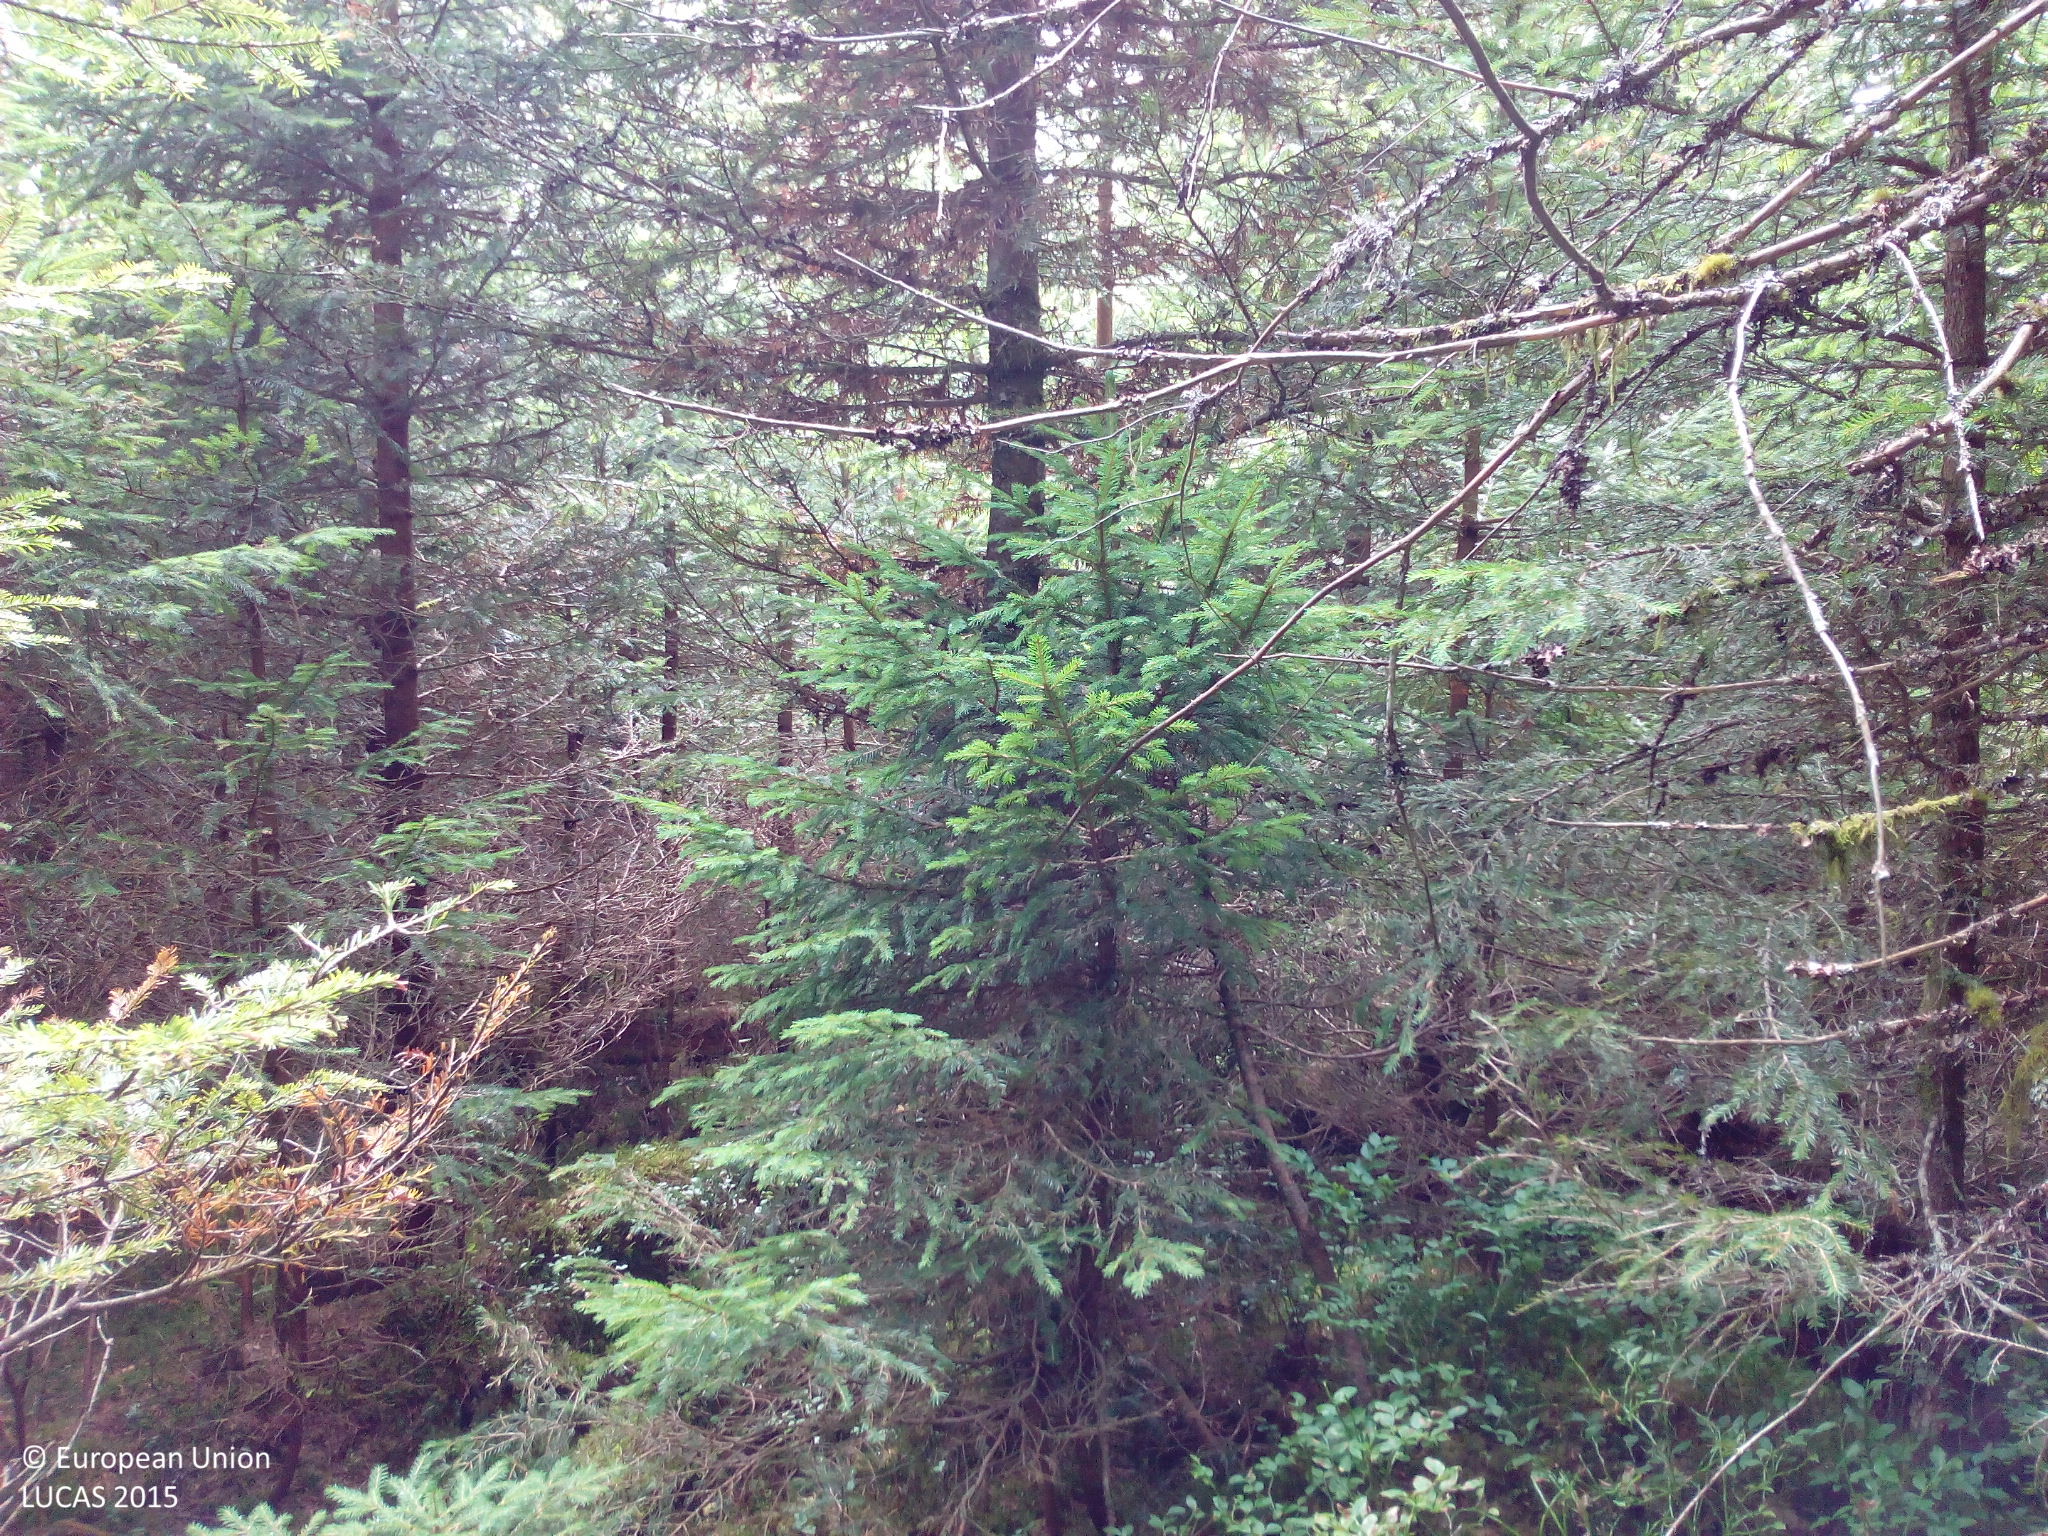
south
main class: Woodland
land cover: Spruce dominated coniferous woodland
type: hemiboreal forest and nemoral coniferous forest and mixed broadleaved-coniferous forest
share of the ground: > 75 %
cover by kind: coniferous forest trees 80 %, shrubs 10 %, lichens and mosses 10 %
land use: Semi-natural and natural areas not in use
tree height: > 5 m
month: August
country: DE
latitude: 47.7768
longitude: 8.1996
